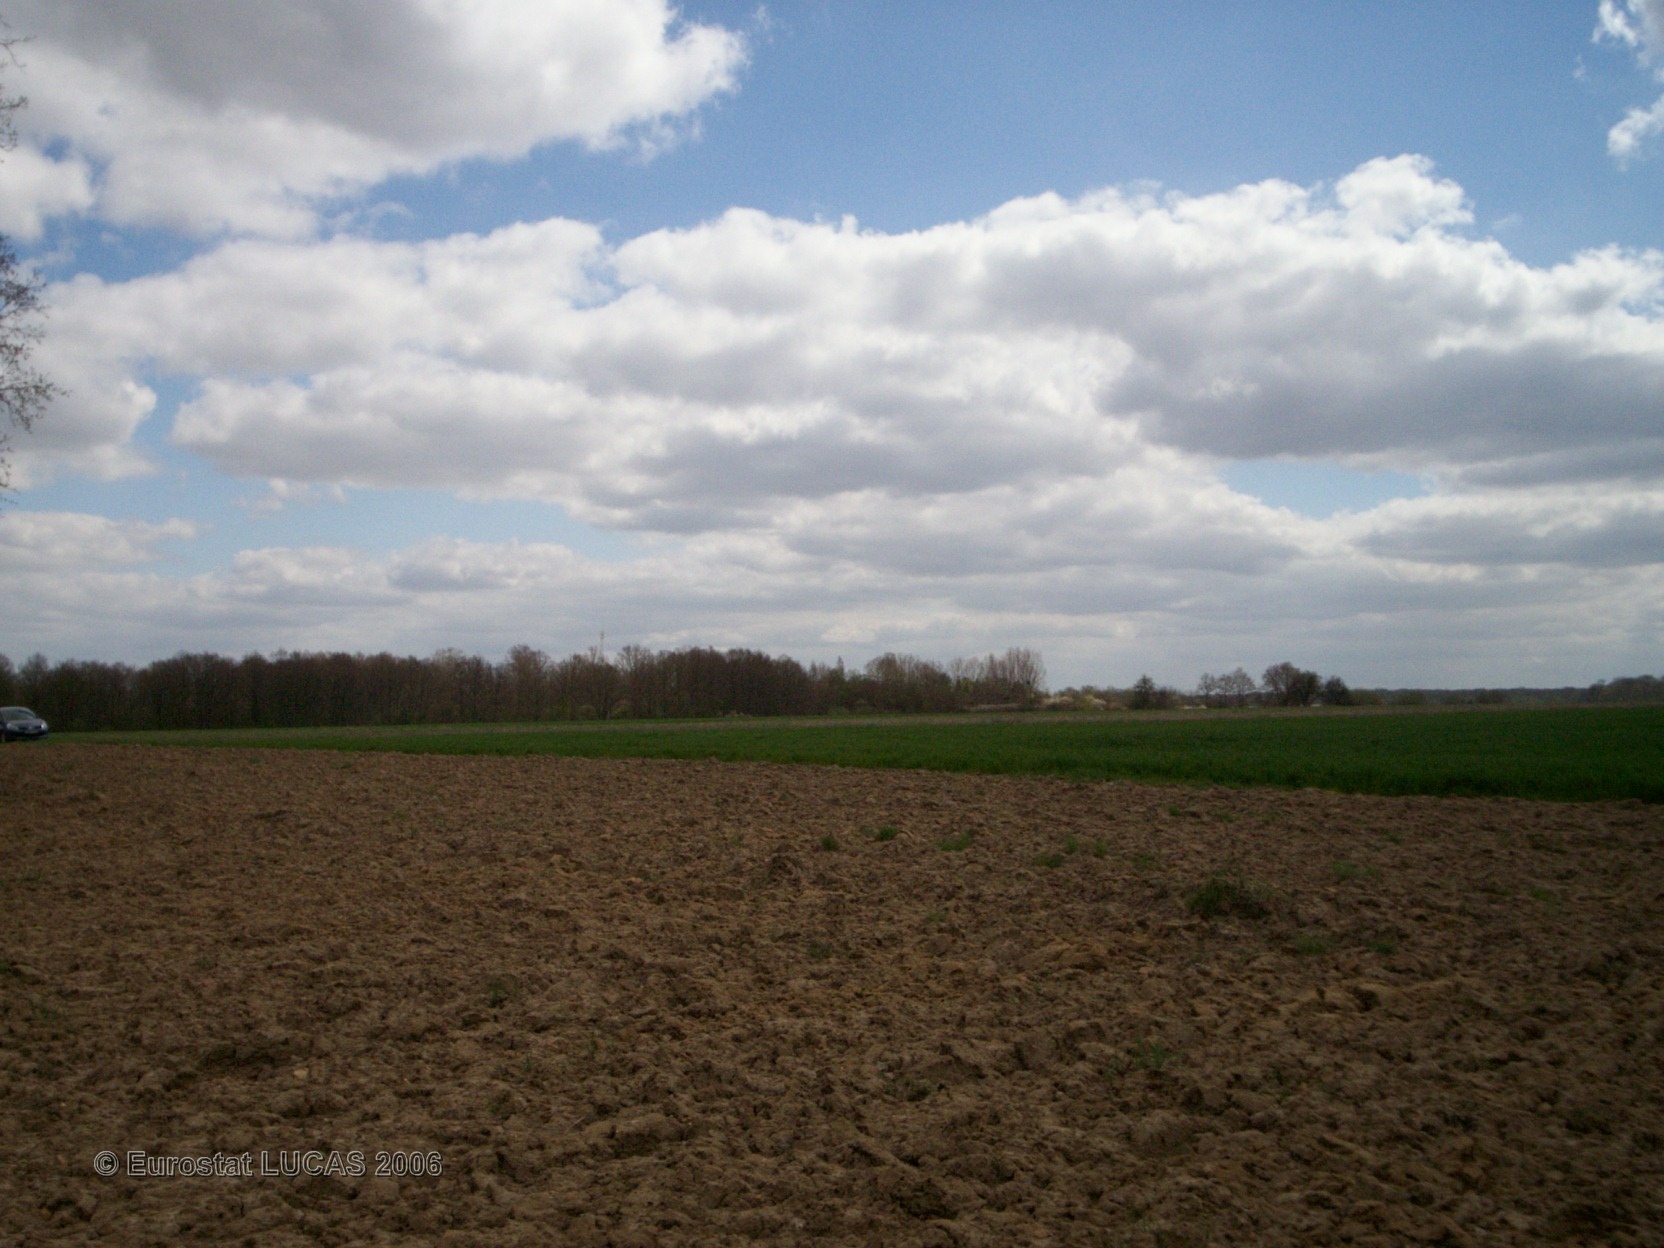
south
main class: Cropland
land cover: Maize
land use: Agriculture (excluding fallow land and kitchen gardens)
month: May
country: FR
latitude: 48.5530
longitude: 2.8786
